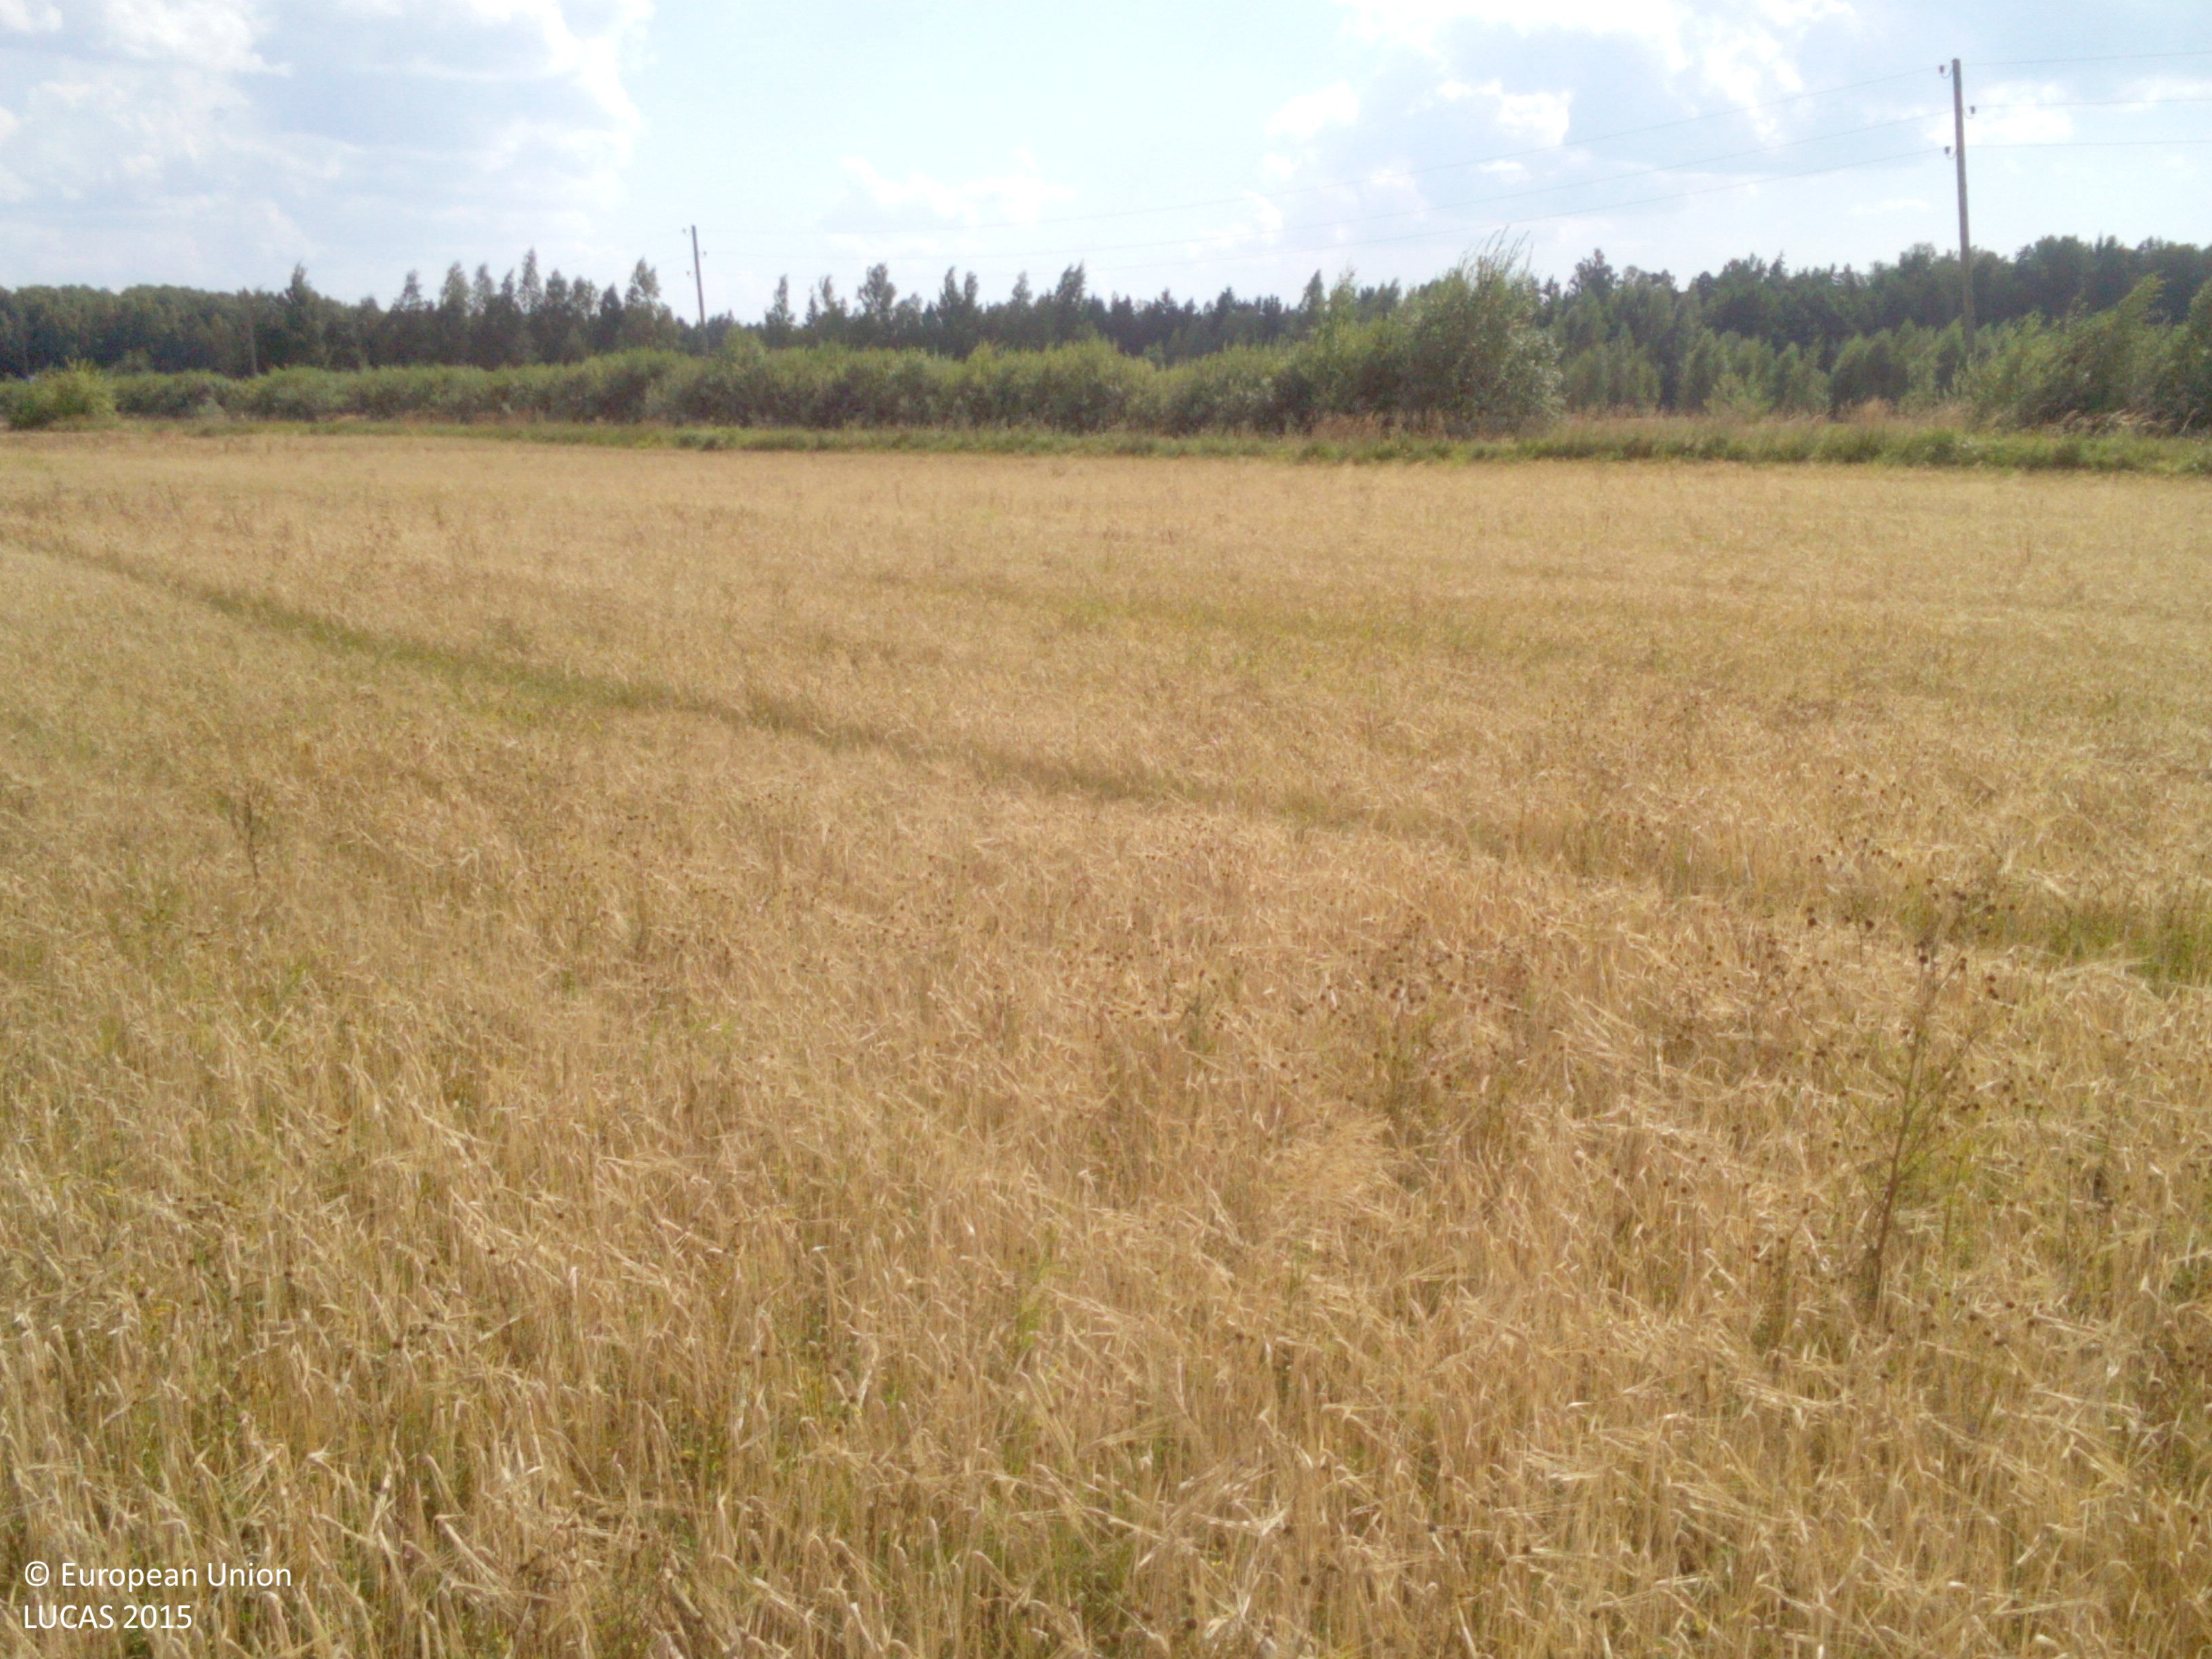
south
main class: Cropland
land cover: Barley
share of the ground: > 75 %
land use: Agriculture (excluding fallow land and kitchen gardens)
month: August
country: LV
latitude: 56.2912
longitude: 21.0396
